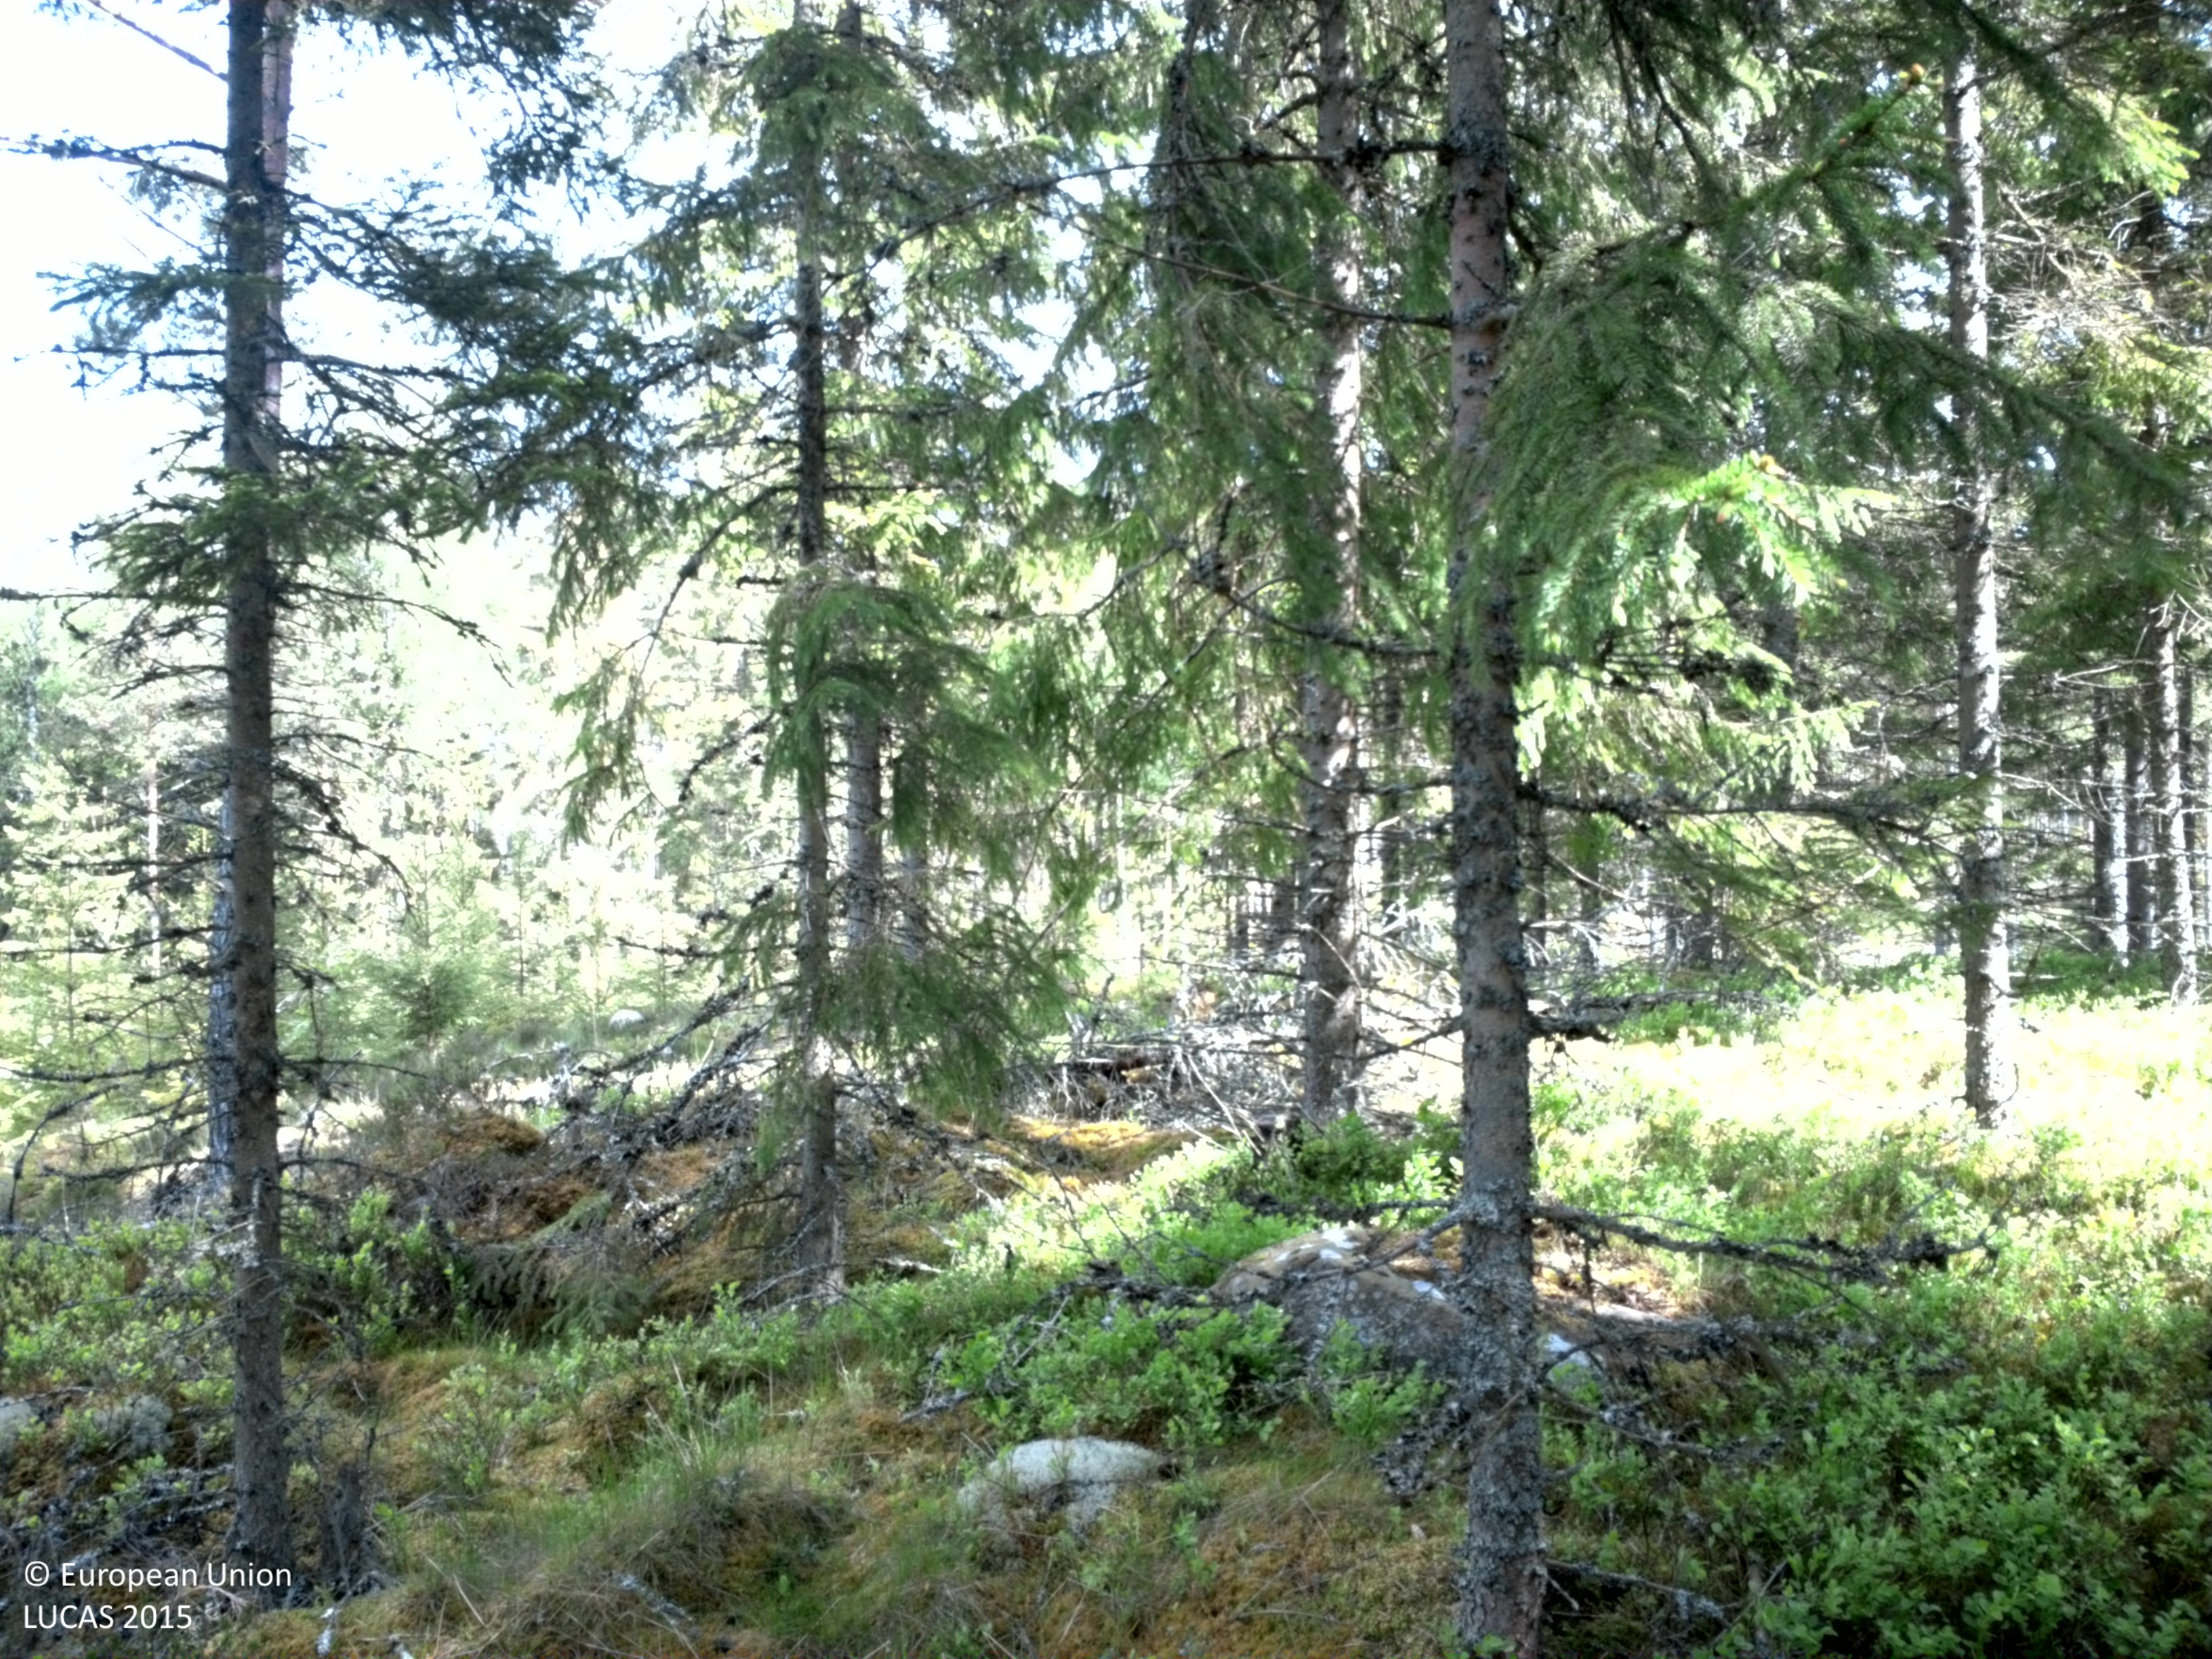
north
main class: Woodland
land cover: Spruce dominated coniferous woodland
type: boreal forest
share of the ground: 50 - 75 %
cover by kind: coniferous forest trees 50 %, shrubs 20 %, lichens and mosses 20 %, herbaceous plants 10 %
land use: Forestry
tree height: > 5 m
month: June
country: SE
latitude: 56.7809
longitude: 14.3340
